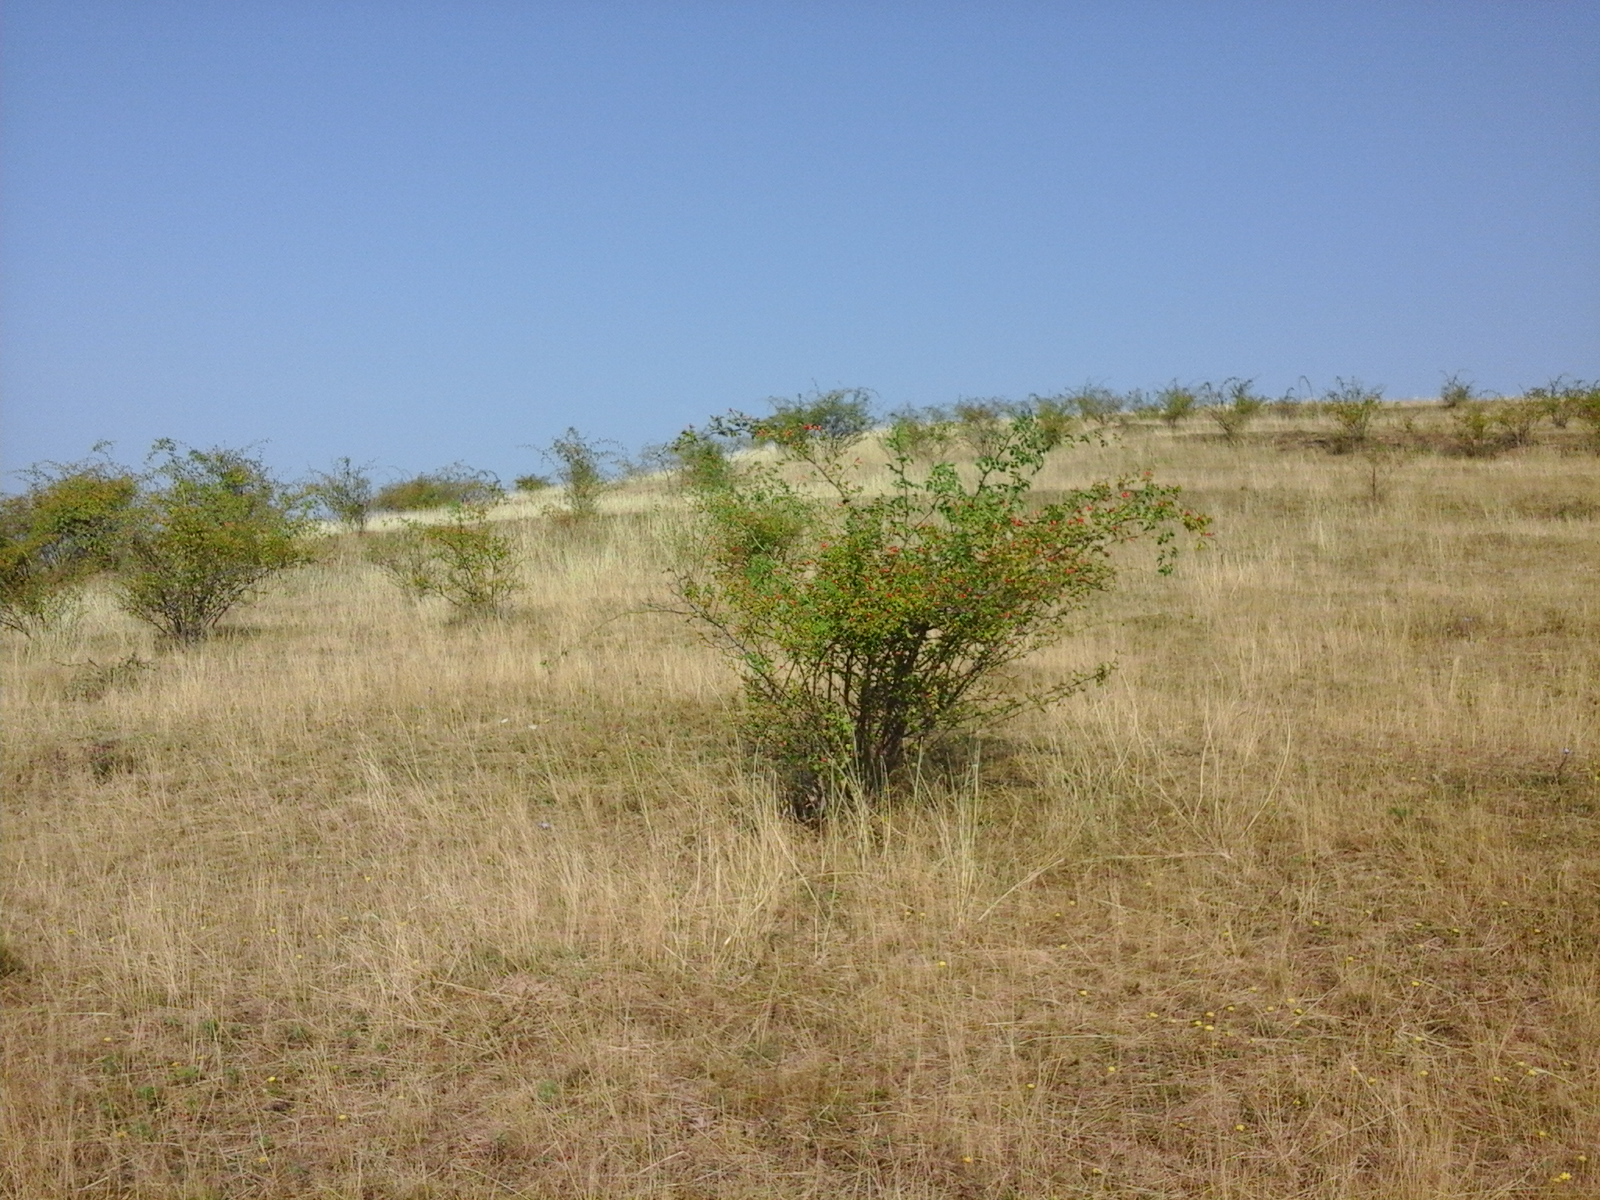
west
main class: Grassland
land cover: Grassland with sparse tree/shrub cover
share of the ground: > 75 %
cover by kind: herbaceous plants 85 %, shrubs 10 %, broadleaved forest trees 5 %
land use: Agriculture (excluding fallow land and kitchen gardens)
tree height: < 5 m
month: September
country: RO
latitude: 47.2567
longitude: 24.2391
